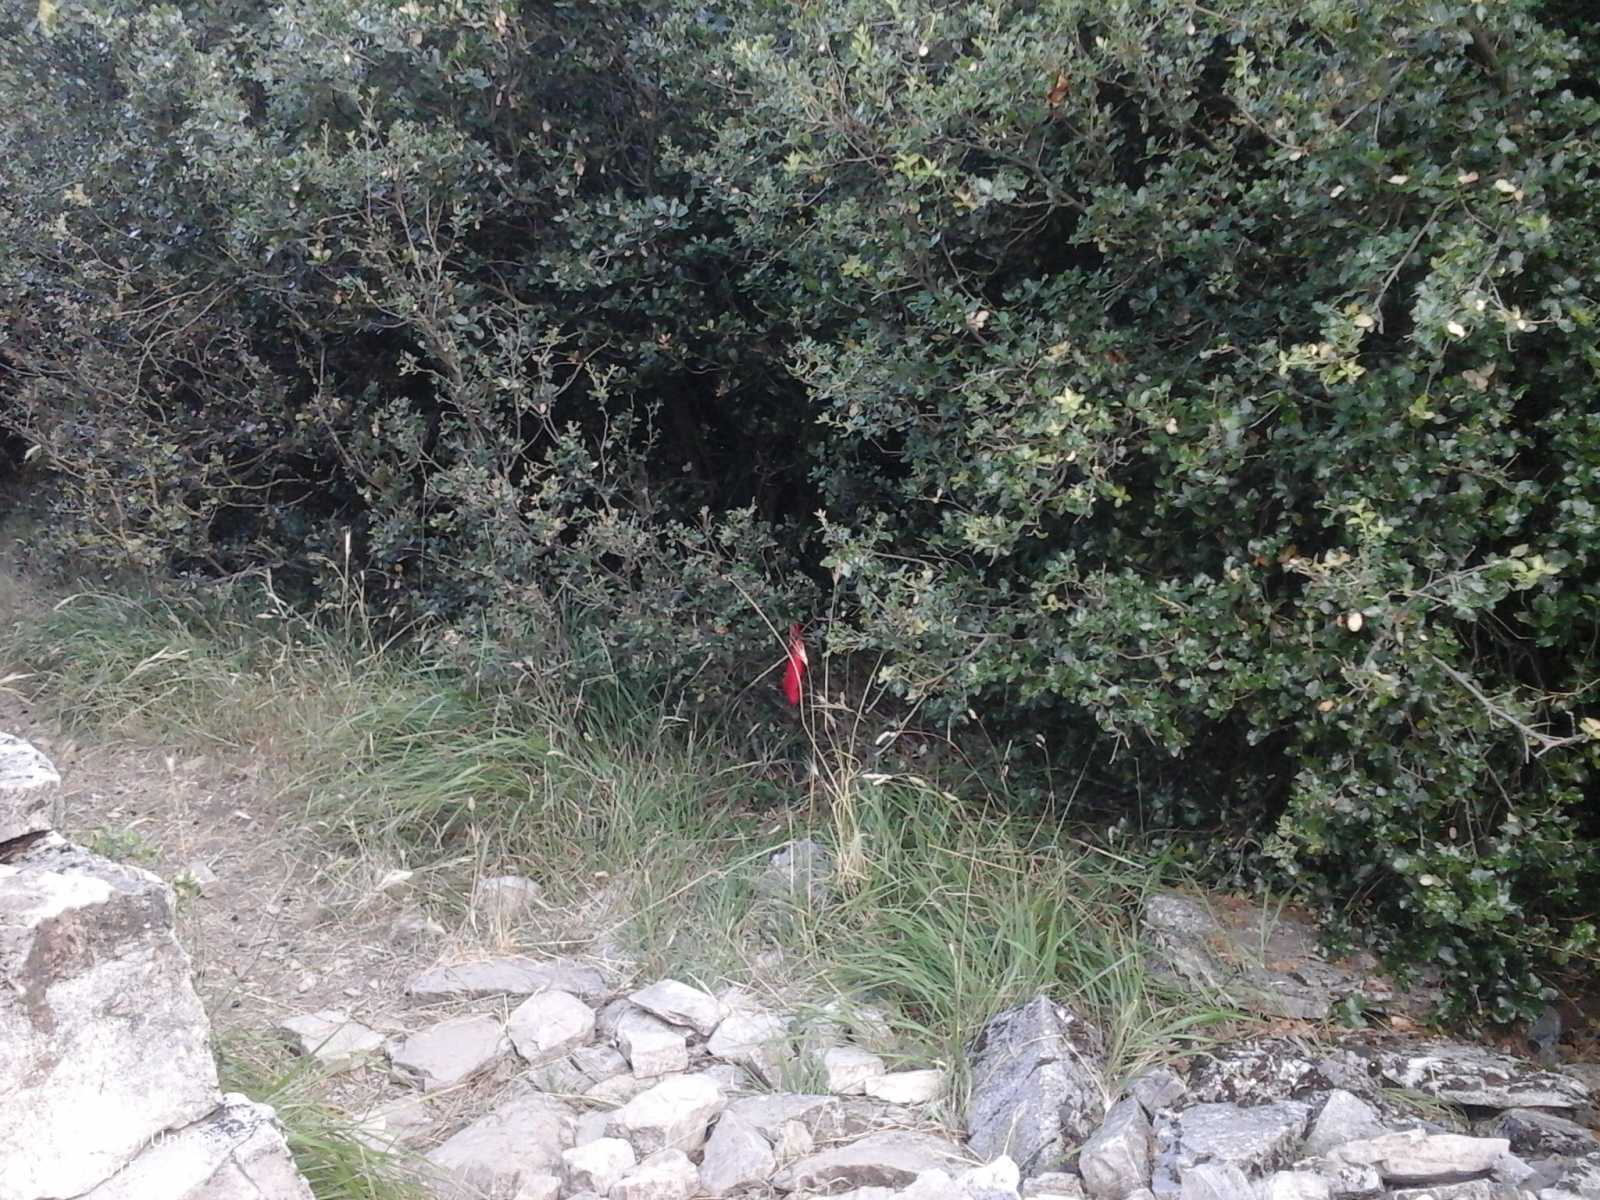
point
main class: Woodland
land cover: Broadleaved woodland
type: broadleaved evergreen forest
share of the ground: > 75 %
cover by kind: broadleaved forest trees 75 %, shrubs 15 %, herbaceous plants 10 %
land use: Semi-natural and natural areas not in use
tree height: > 5 m
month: July
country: GR
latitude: 39.5735
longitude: 21.0026
